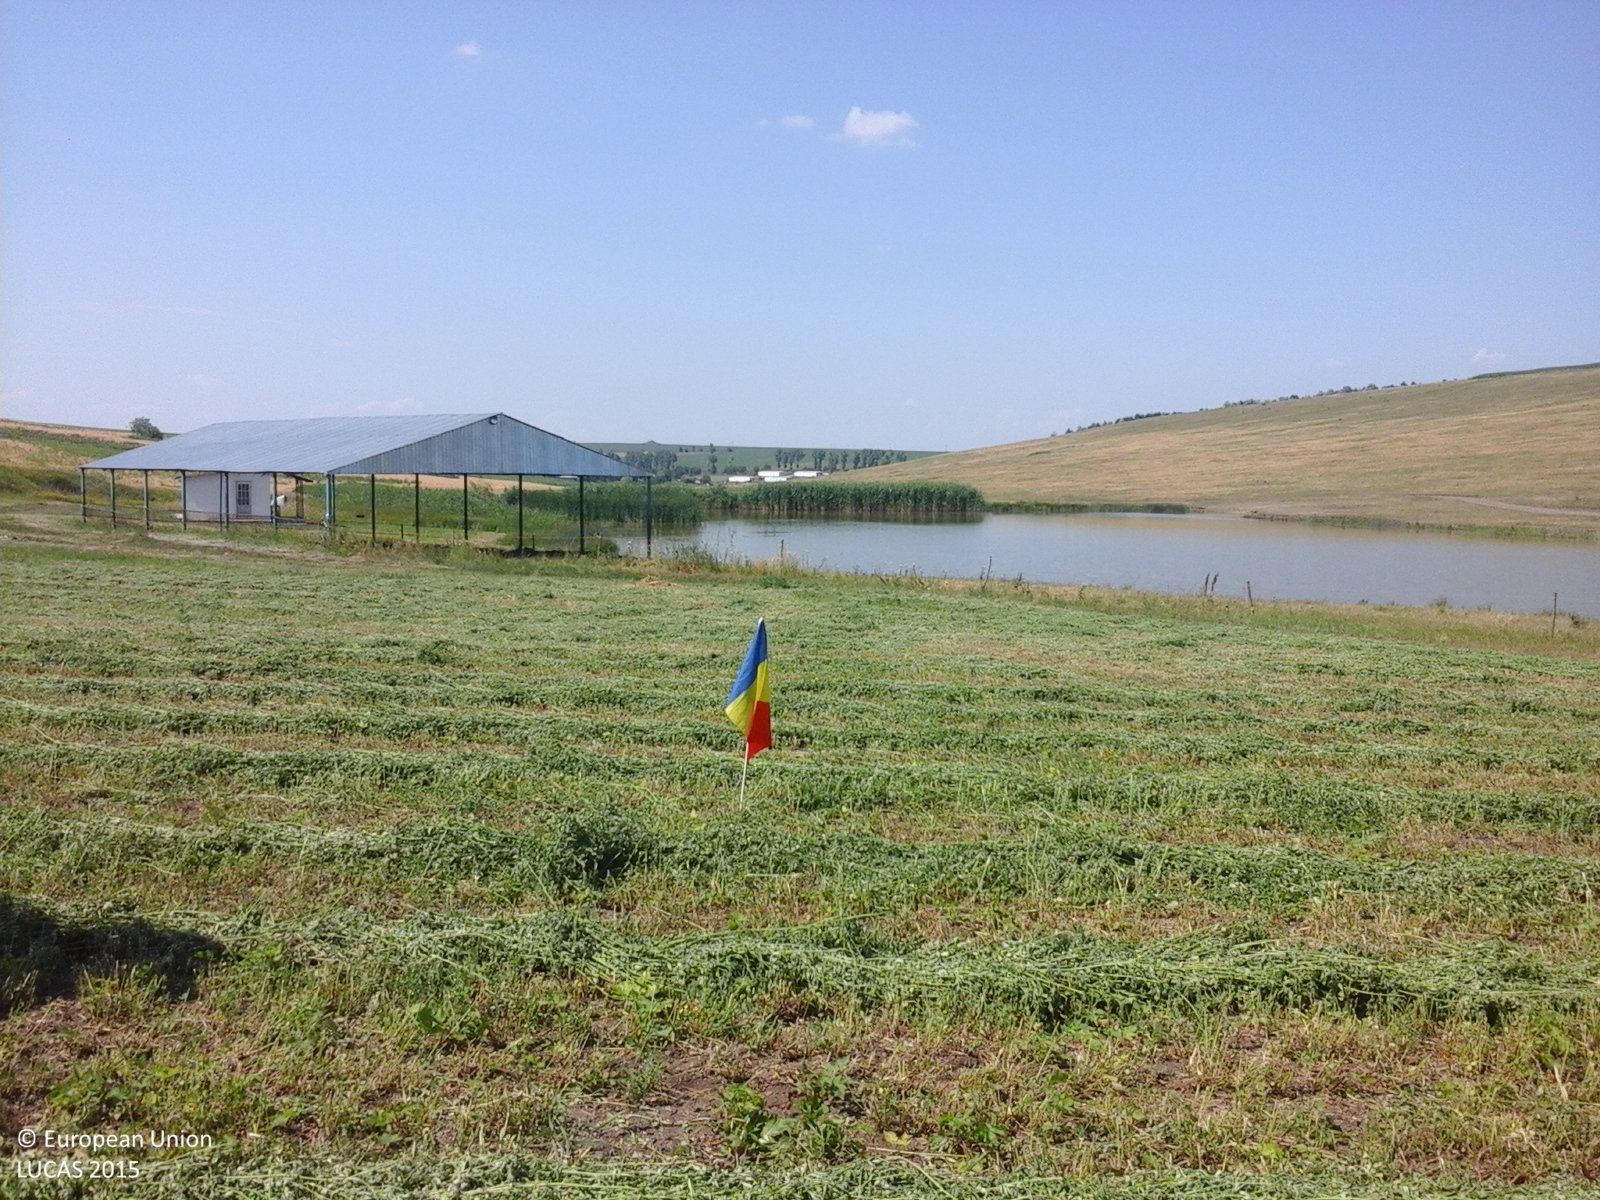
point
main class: Cropland
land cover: Lucerne
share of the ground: 10 - 25 %
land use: Agriculture (excluding fallow land and kitchen gardens)
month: June
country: RO
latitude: 47.3081
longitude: 27.3745
